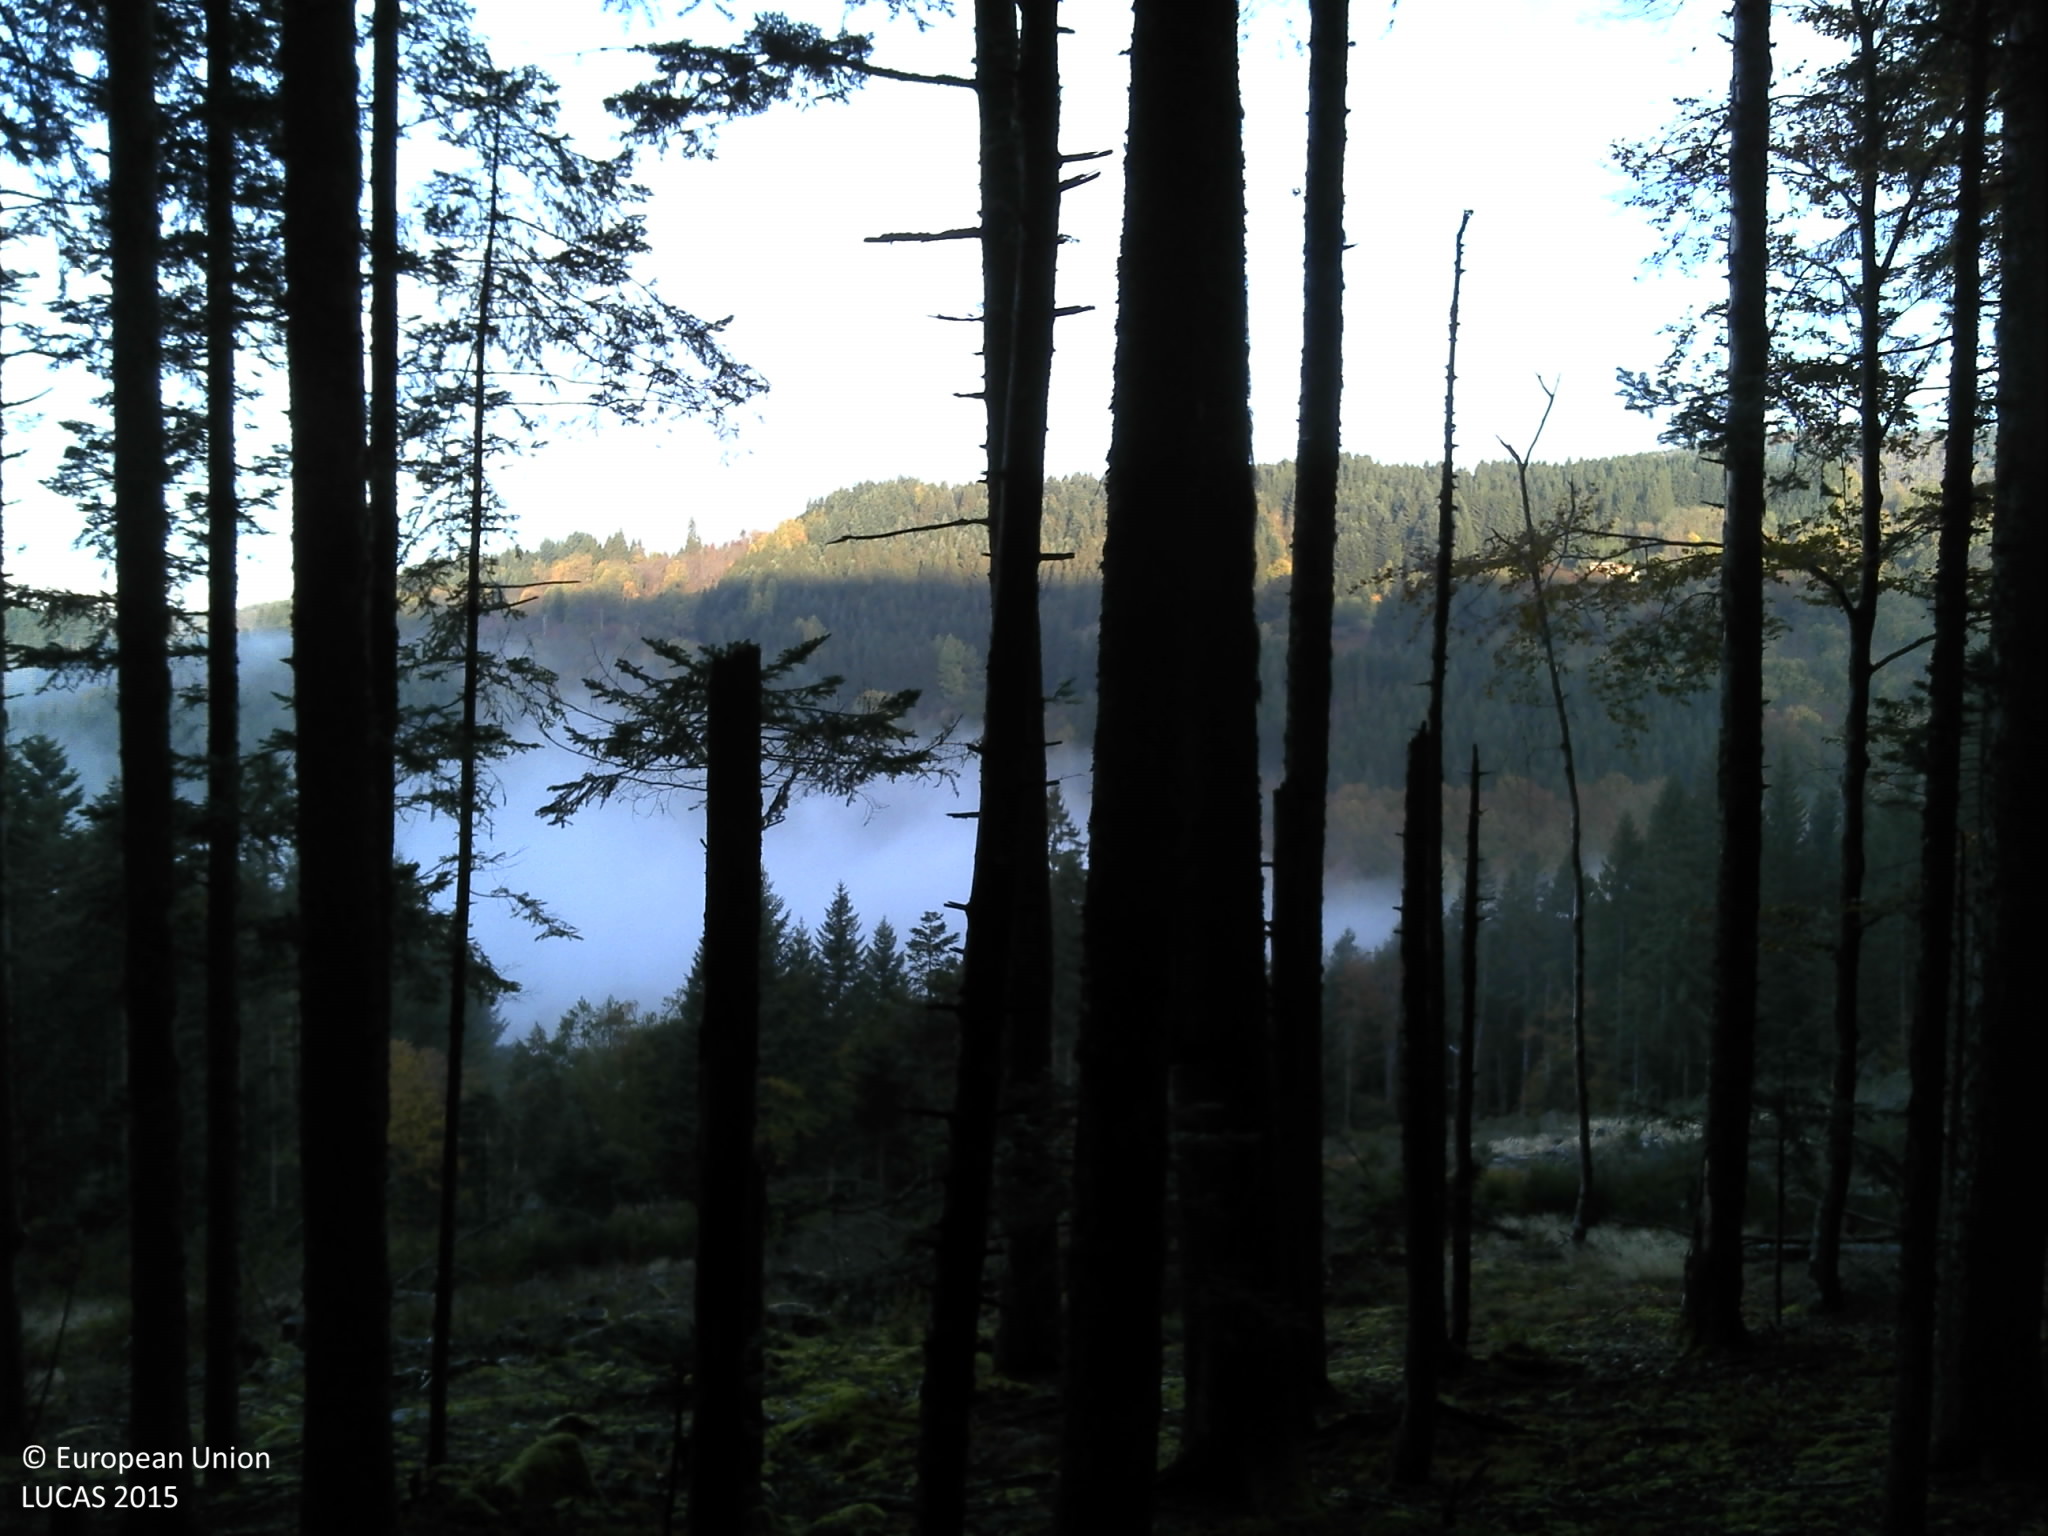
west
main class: Woodland
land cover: Other coniferous woodland
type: exotic forest
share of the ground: > 75 %
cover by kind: coniferous forest trees 85 %, broadleaved forest trees 5 %, herbaceous plants 5 %, lichens and mosses 5 %
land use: Forestry
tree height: > 5 m
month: October
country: FR
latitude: 45.7344
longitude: 3.7432
